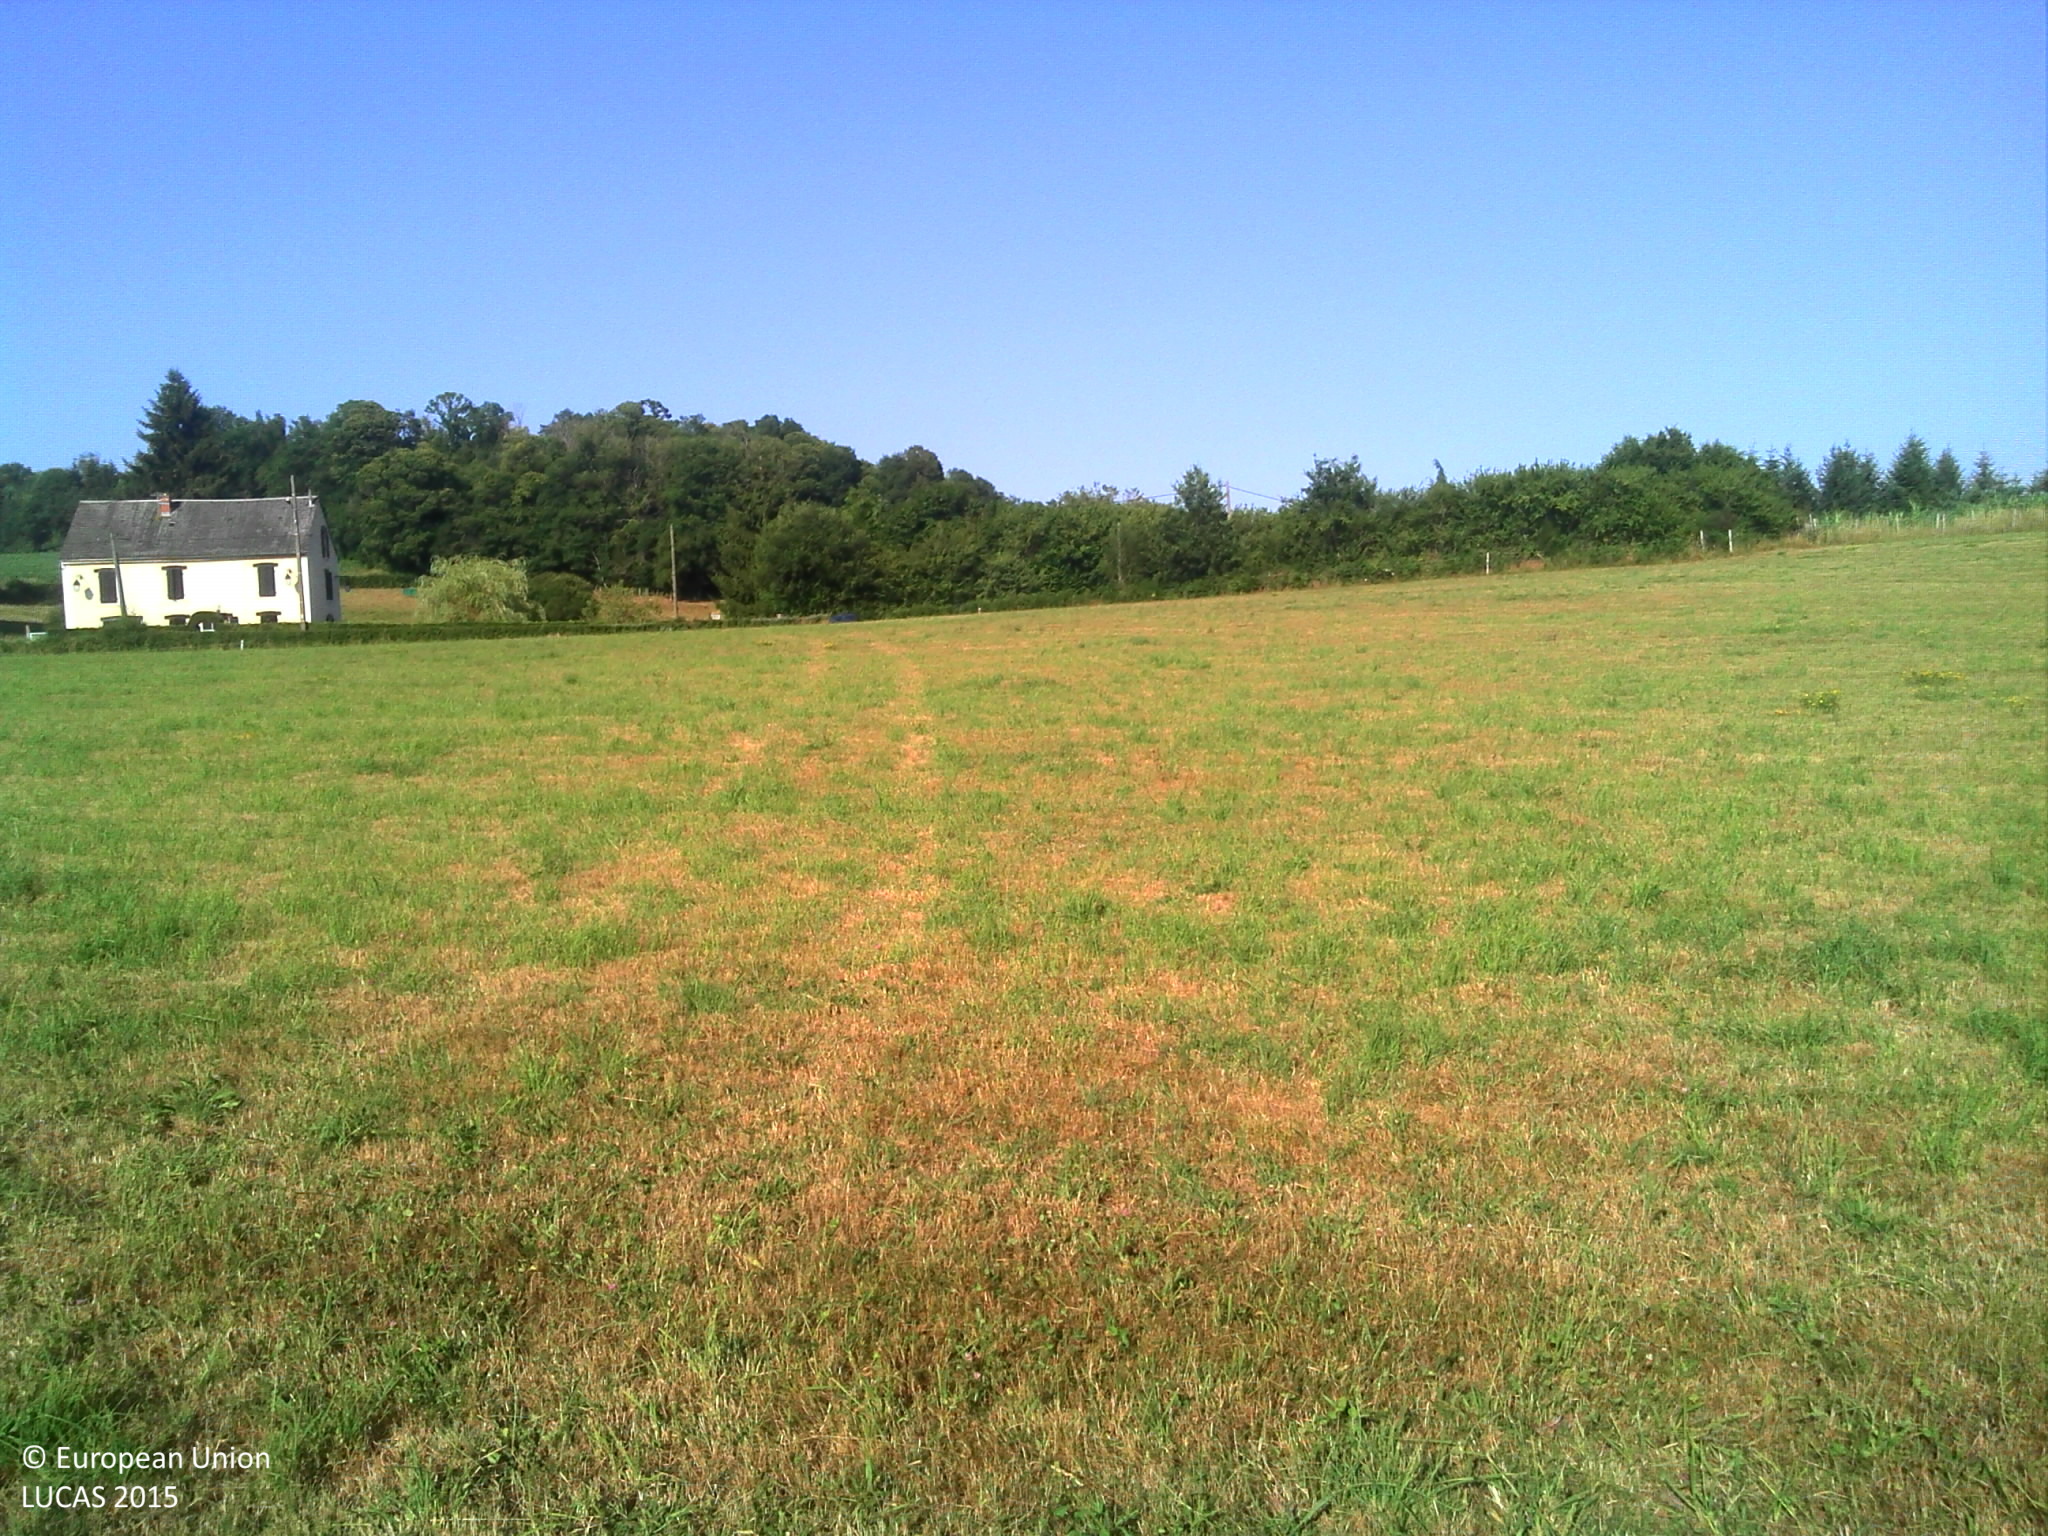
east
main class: Grassland
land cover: Grassland without tree/shrub cover
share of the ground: > 75 %
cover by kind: herbaceous plants 100 %
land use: Agriculture (excluding fallow land and kitchen gardens)
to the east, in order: Grassland without tree/shrub cover; Fences; Managed hedges; Tracks; Fences; Grass margins; Maize; Managed hedges; Fences; Electric lines; Ditches and canals; Grass margins; Paved roads, cycling and walking lanes; Grass margins; Managed hedges; Spruce dominated mixed woodland; Grassland without tree/shrub cover; Ditches and canals; Grass margins; Paved roads, cycling and walking lanes; Grass margins; Spontaneously vegetated surfaces; Grassland without tree/shrub cover
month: July
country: FR
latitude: 46.0987
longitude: 1.6747
